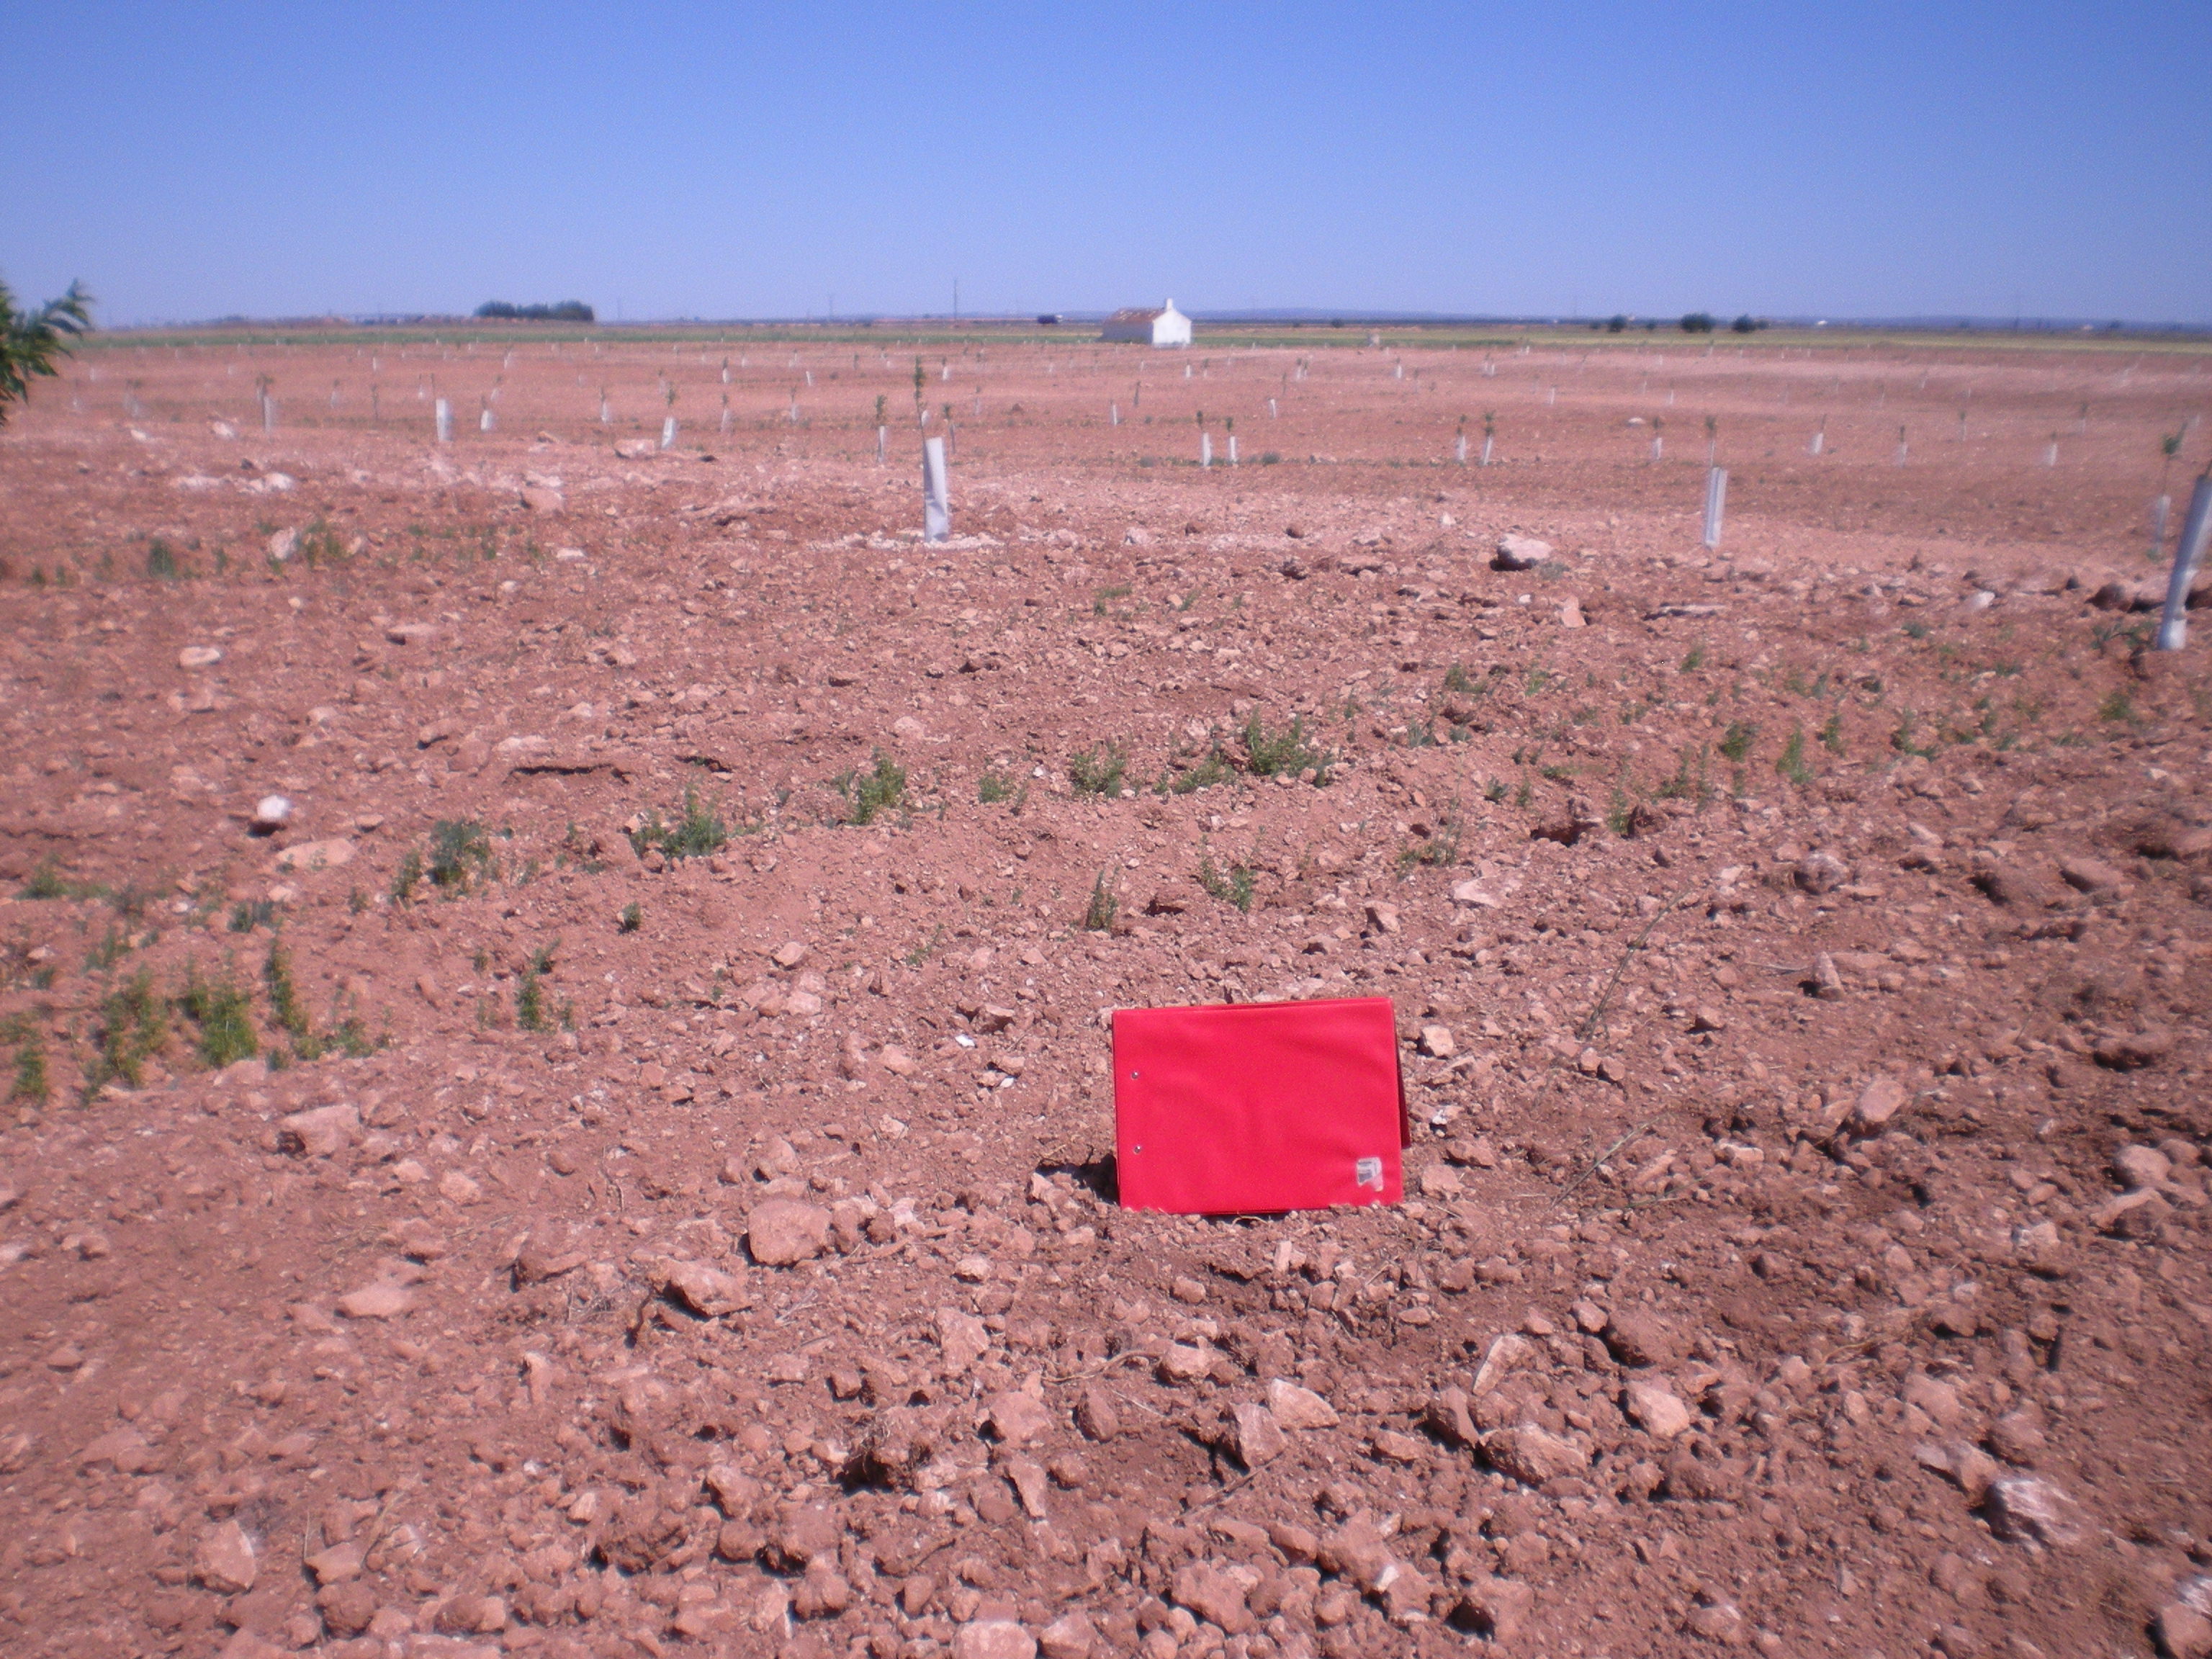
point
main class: Cropland
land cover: Nuts trees
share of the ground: < 10 %
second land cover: Other bare soil
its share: > 75 %
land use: Agriculture (excluding fallow land and kitchen gardens)
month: May
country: ES
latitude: 39.0956
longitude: -3.2063
